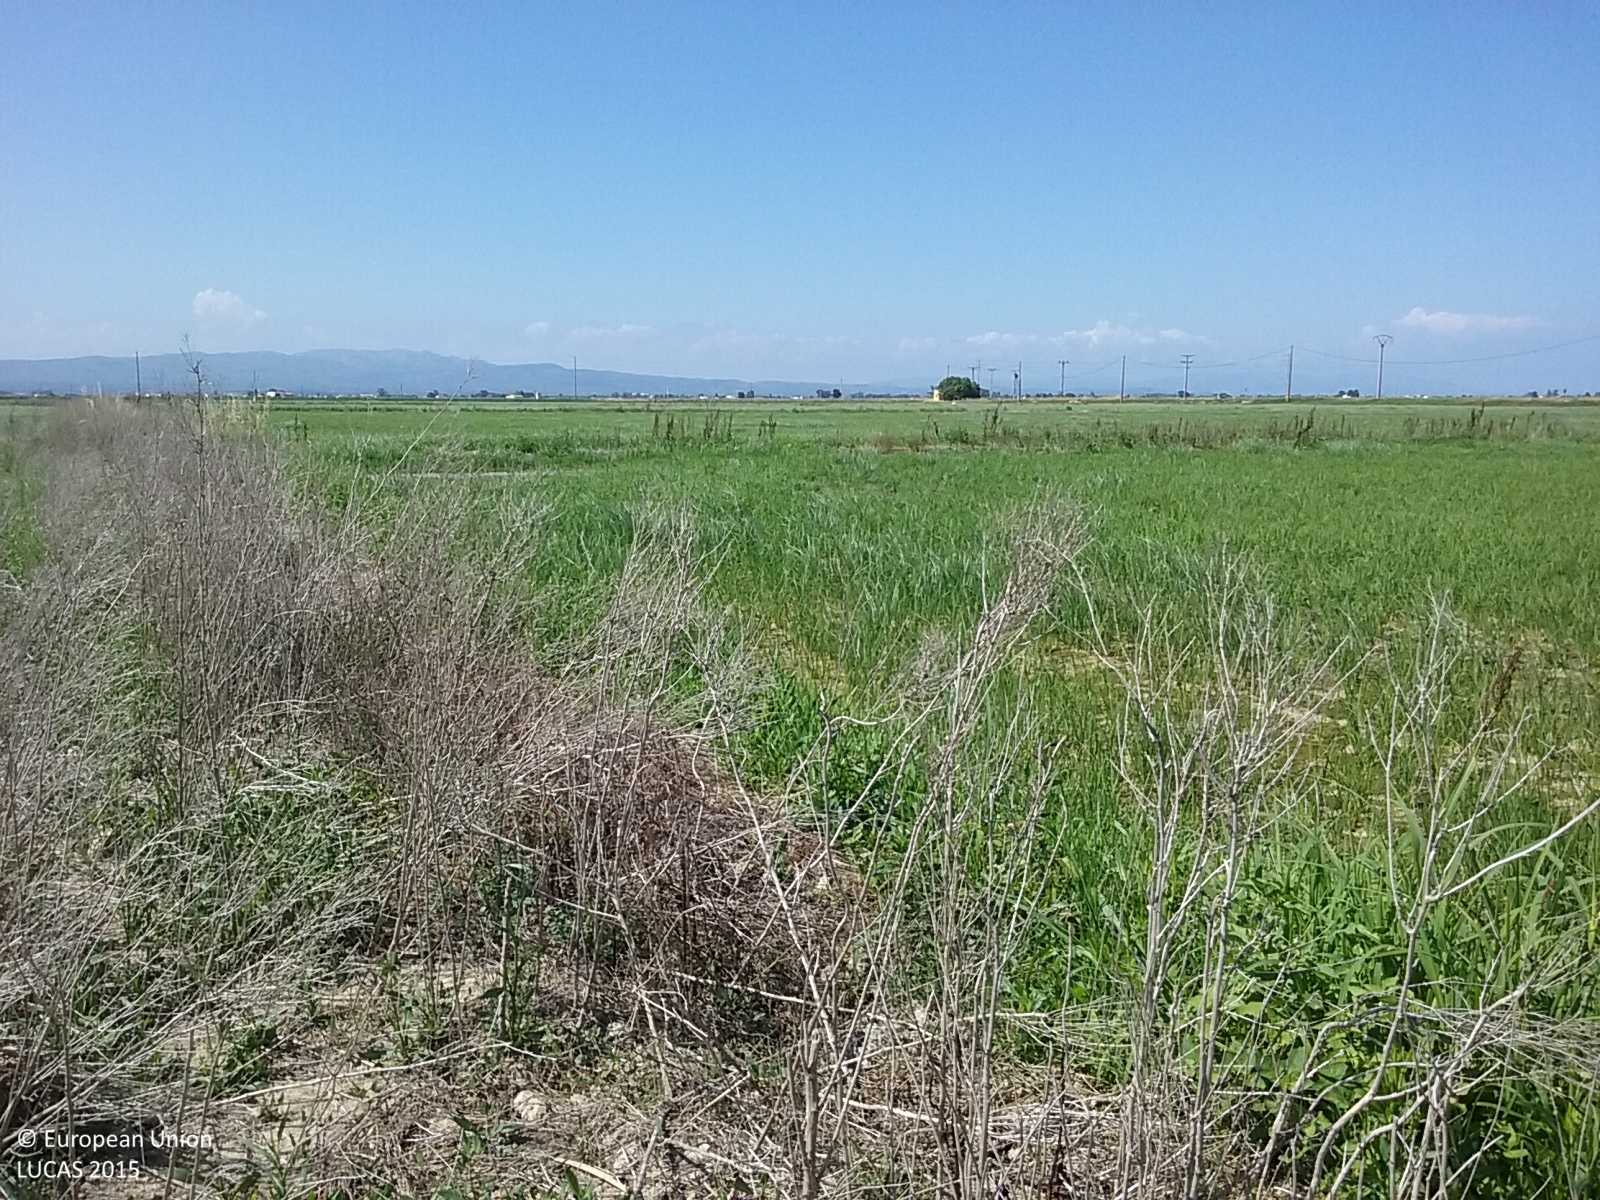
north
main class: Cropland
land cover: Rice
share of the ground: 50 - 75 %
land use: Agriculture (excluding fallow land and kitchen gardens)
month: June
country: ES
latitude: 40.6785
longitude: 0.6845
